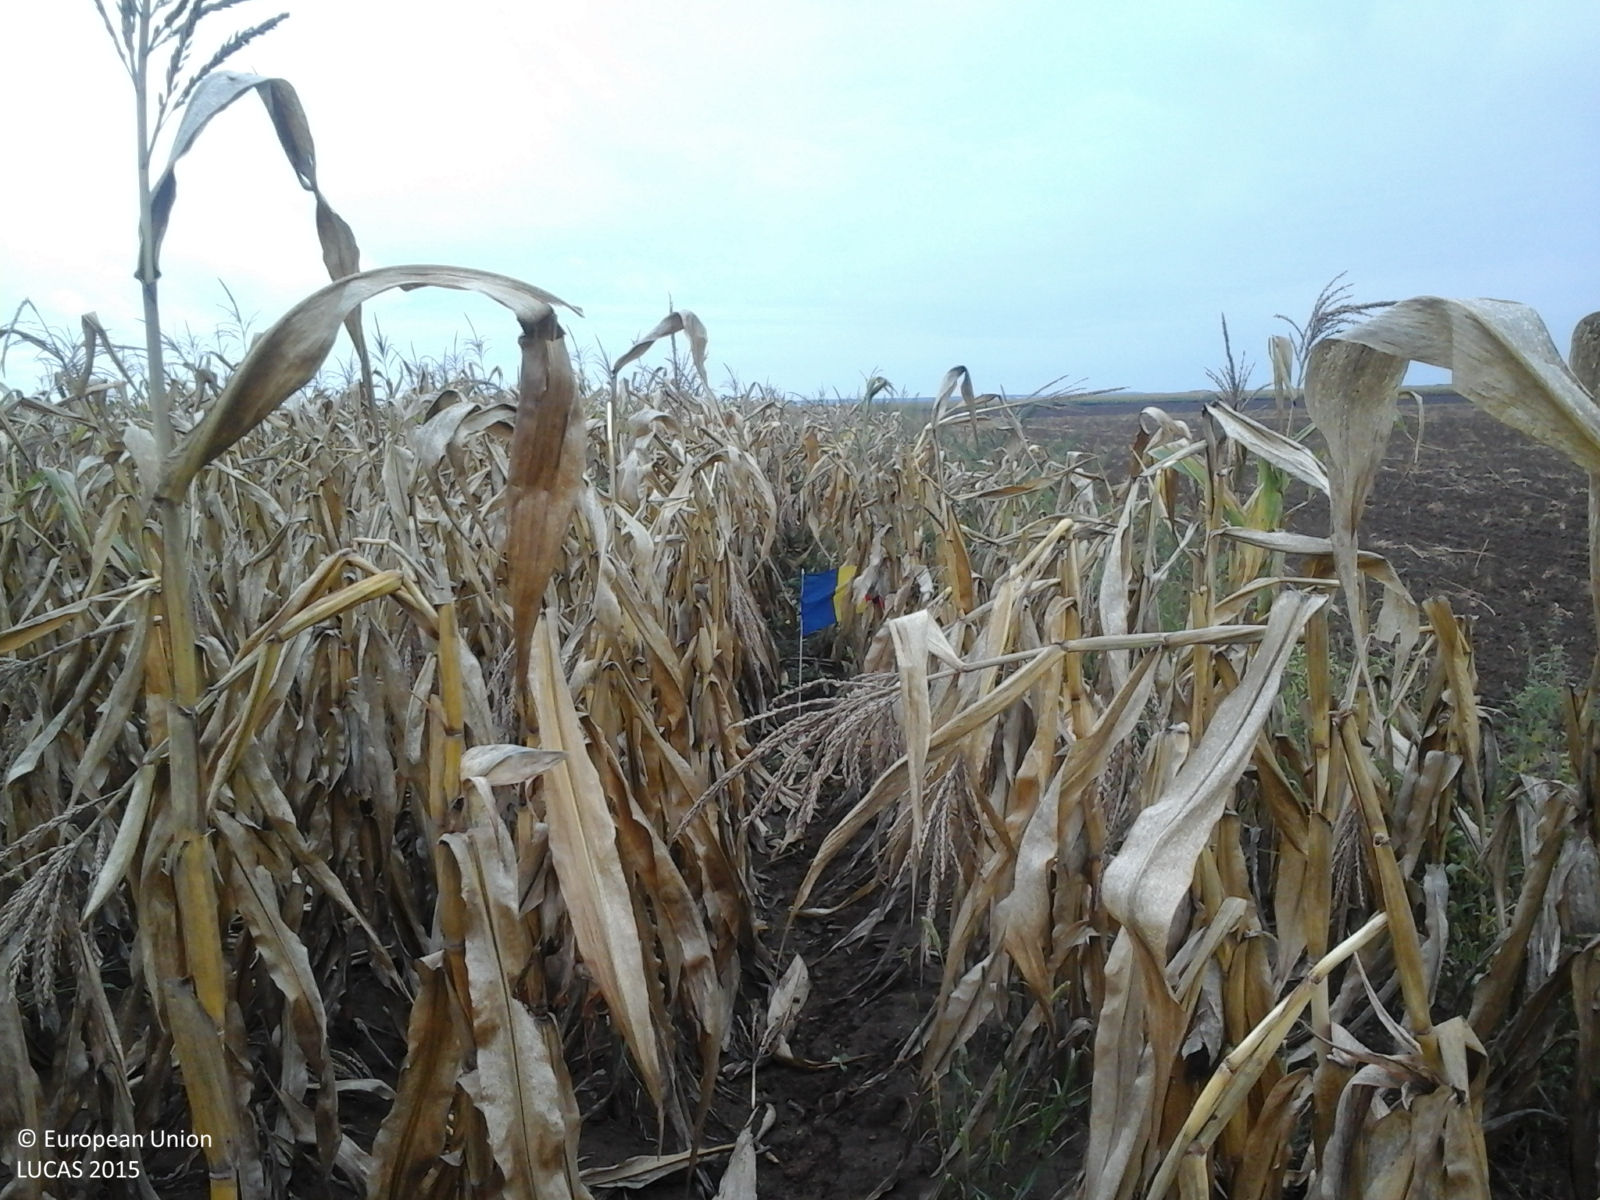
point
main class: Cropland
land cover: Maize
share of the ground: > 75 %
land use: Agriculture (excluding fallow land and kitchen gardens)
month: September
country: RO
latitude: 47.0007
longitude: 21.8416
